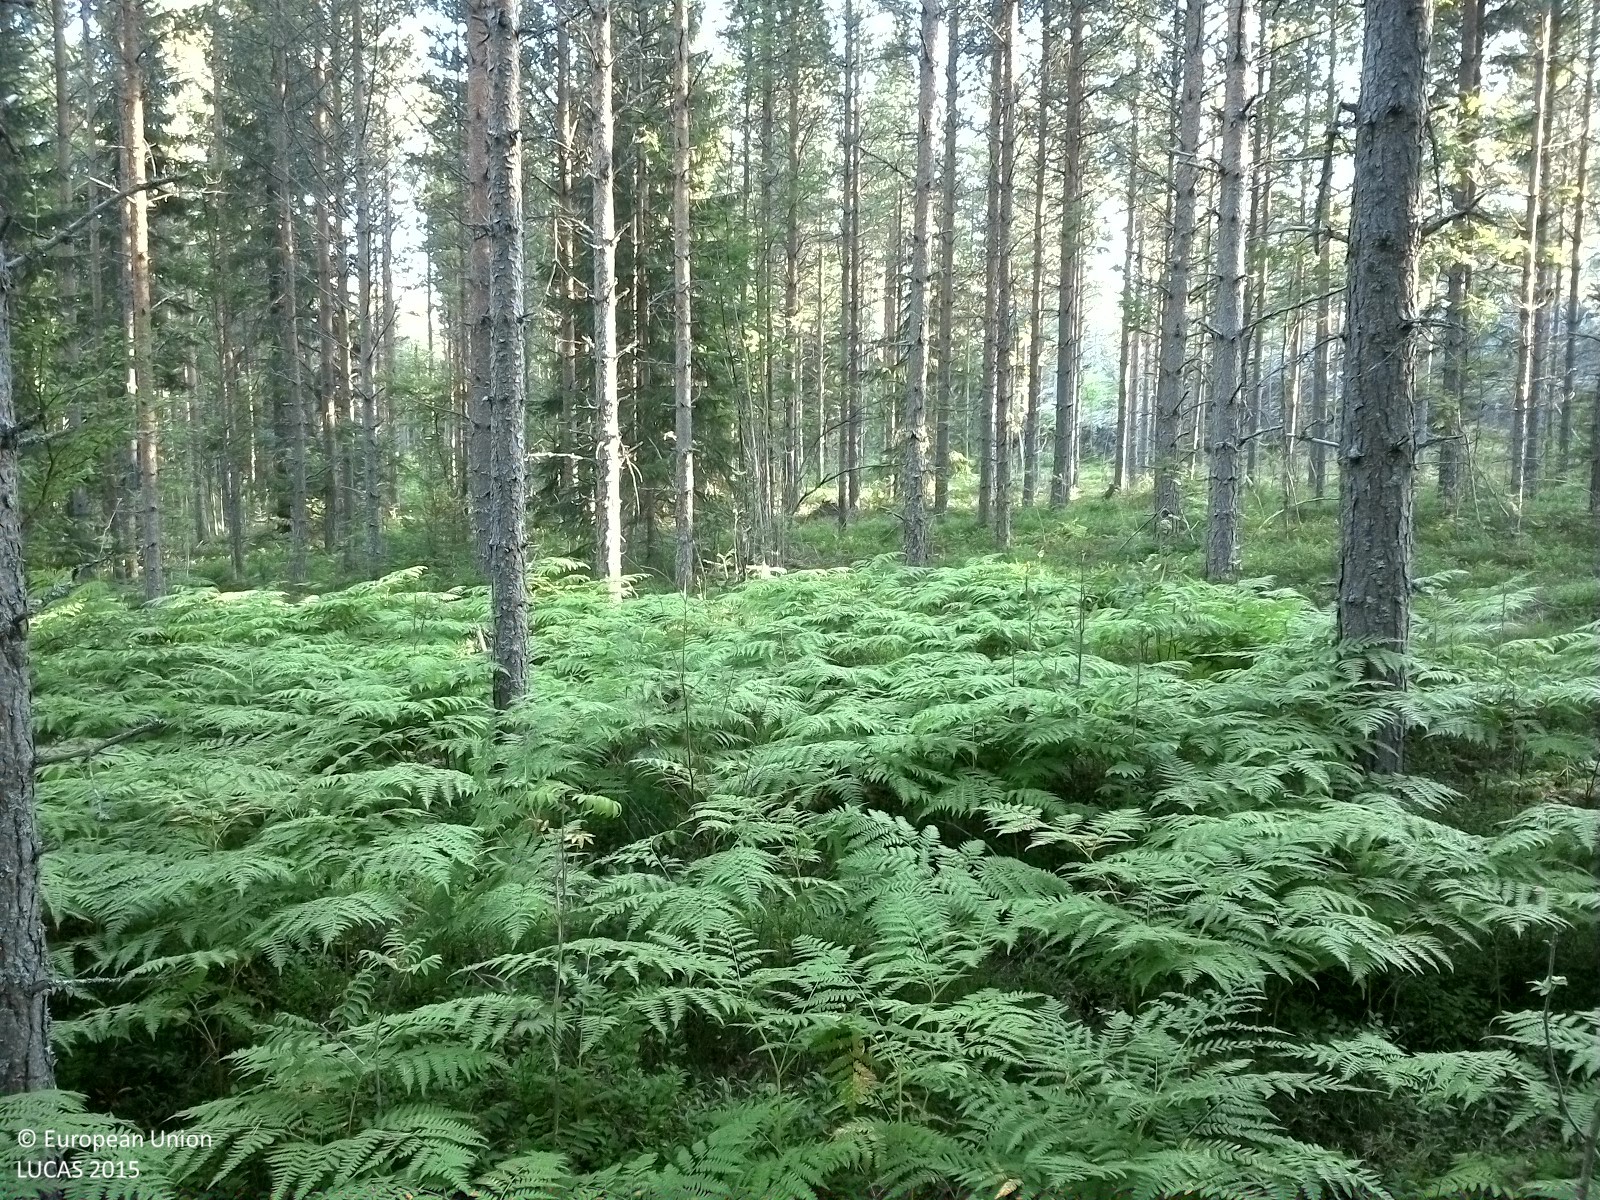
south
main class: Woodland
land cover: Pine dominated coniferous woodland
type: boreal forest
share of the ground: 50 - 75 %
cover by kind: coniferous forest trees 55 %, herbaceous plants 30 %, shrubs 15 %
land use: Forestry
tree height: > 5 m
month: August
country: SE
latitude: 62.5859
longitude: 17.9042
